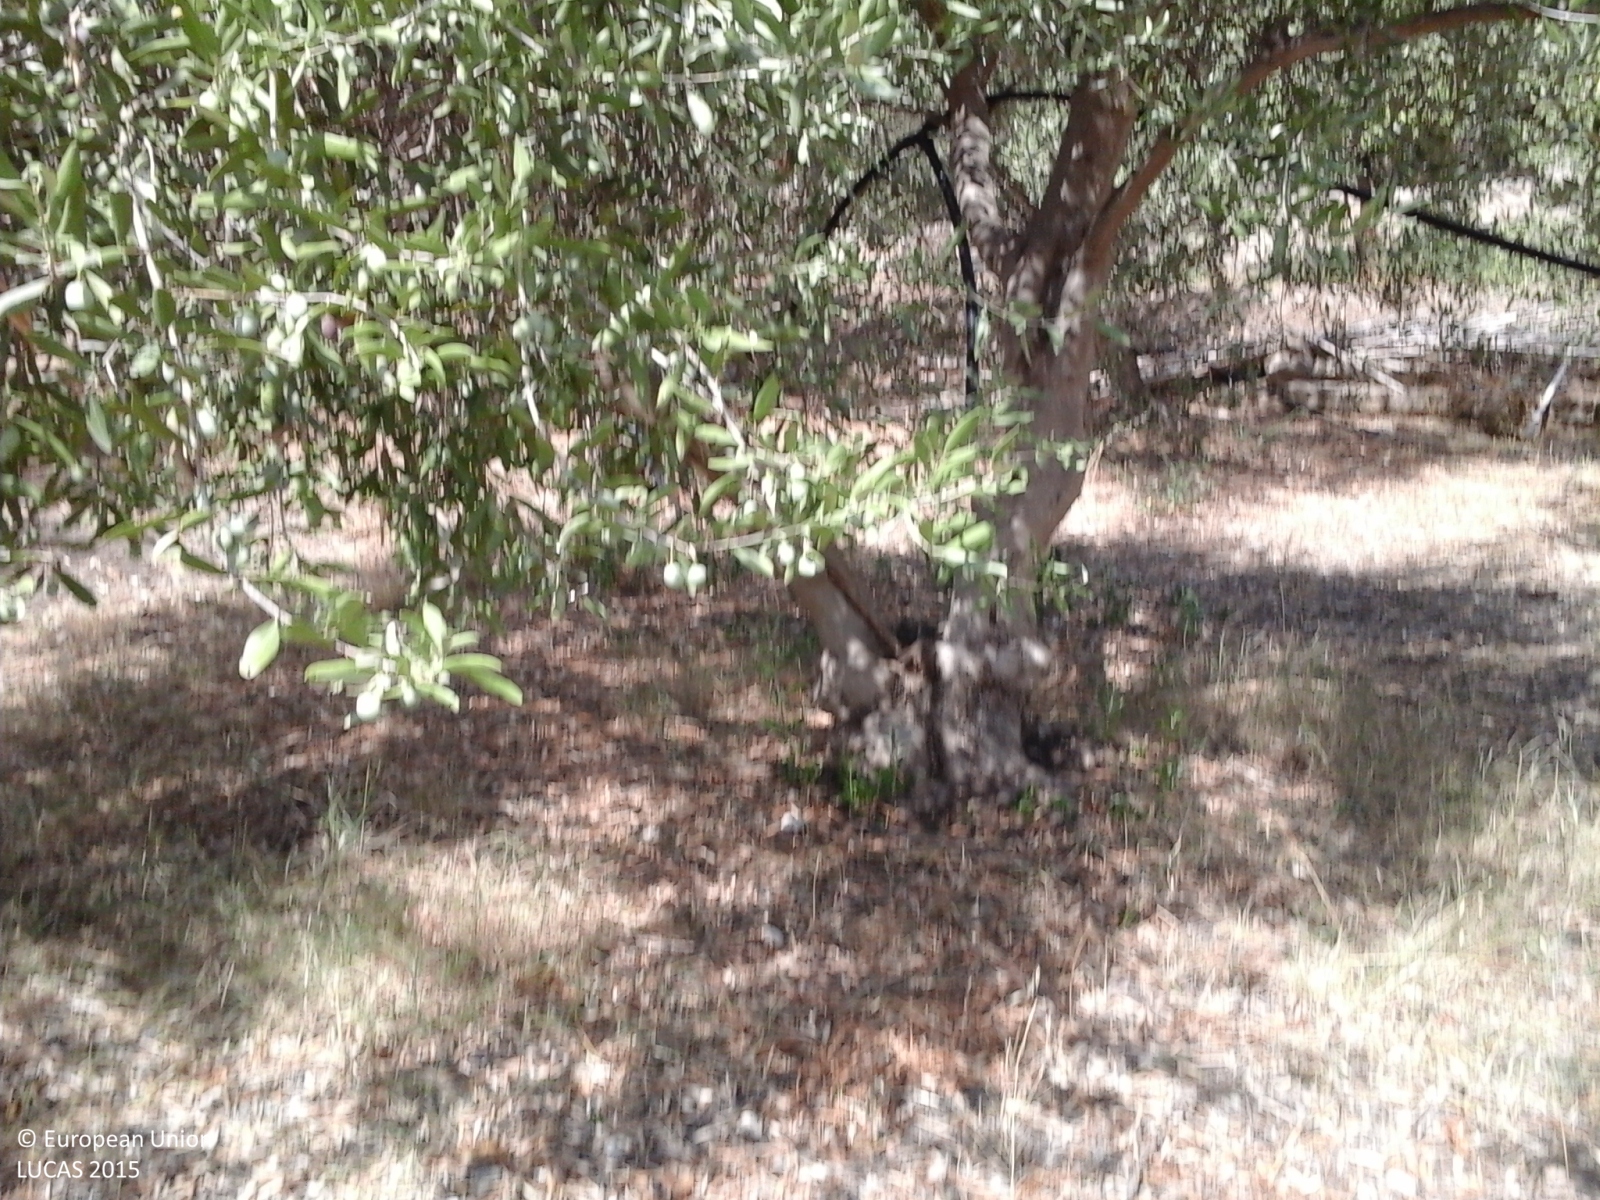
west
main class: Cropland
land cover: Olive groves
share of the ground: > 75 %
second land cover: Spontaneously vegetated surfaces
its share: > 75 %
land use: Agriculture (excluding fallow land and kitchen gardens)
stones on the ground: < 10 %
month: August
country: IT
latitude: 37.2976
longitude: 14.8261
